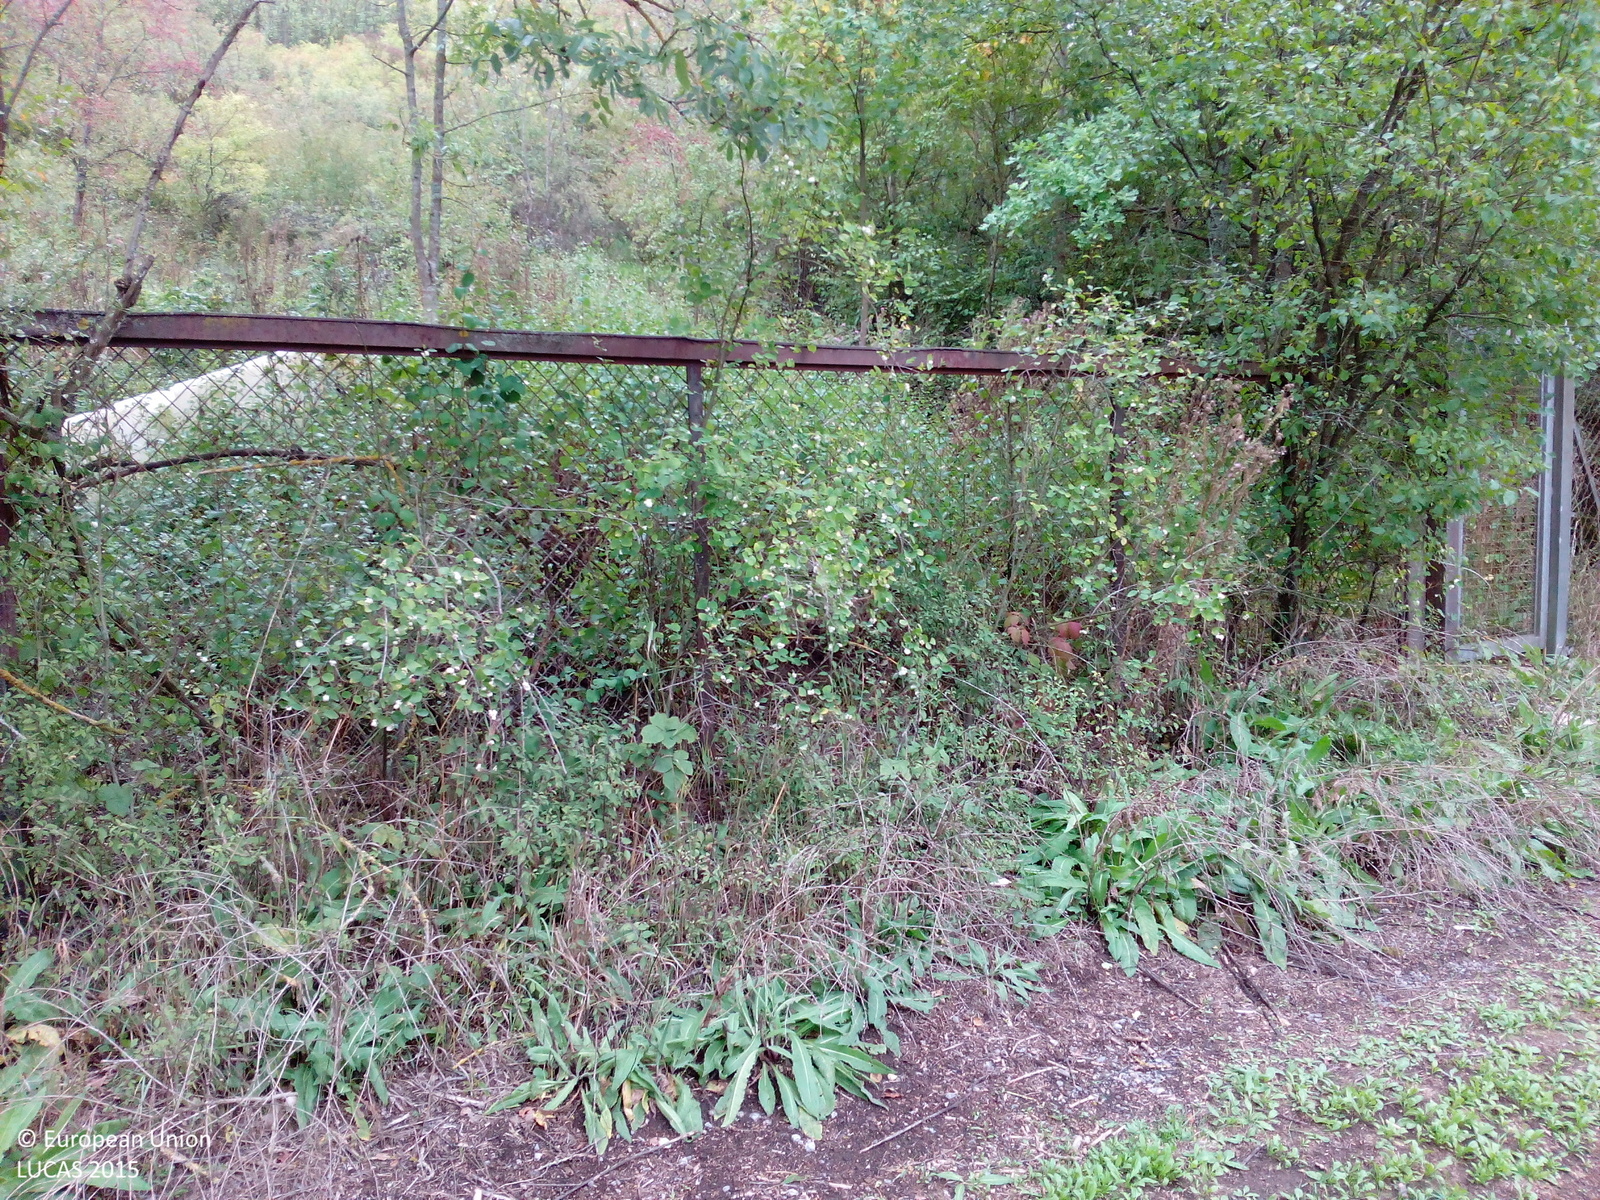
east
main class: Cropland
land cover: Apple fruit
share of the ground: > 75 %
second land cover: Grassland without tree/shrub cover
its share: > 75 %
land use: Kitchen garden
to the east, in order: Apple fruit; Grassland without tree/shrub cover; Artificial constructions in urban areas; Tracks; Grass margins; Fences; Broadleaved woodland; Fences; Grassland without tree/shrub cover; Other bare soil; Shrubland with sparse tree cover; Grass margins; Tracks; Other bare soil
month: September
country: DE
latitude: 49.8425
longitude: 9.9583
